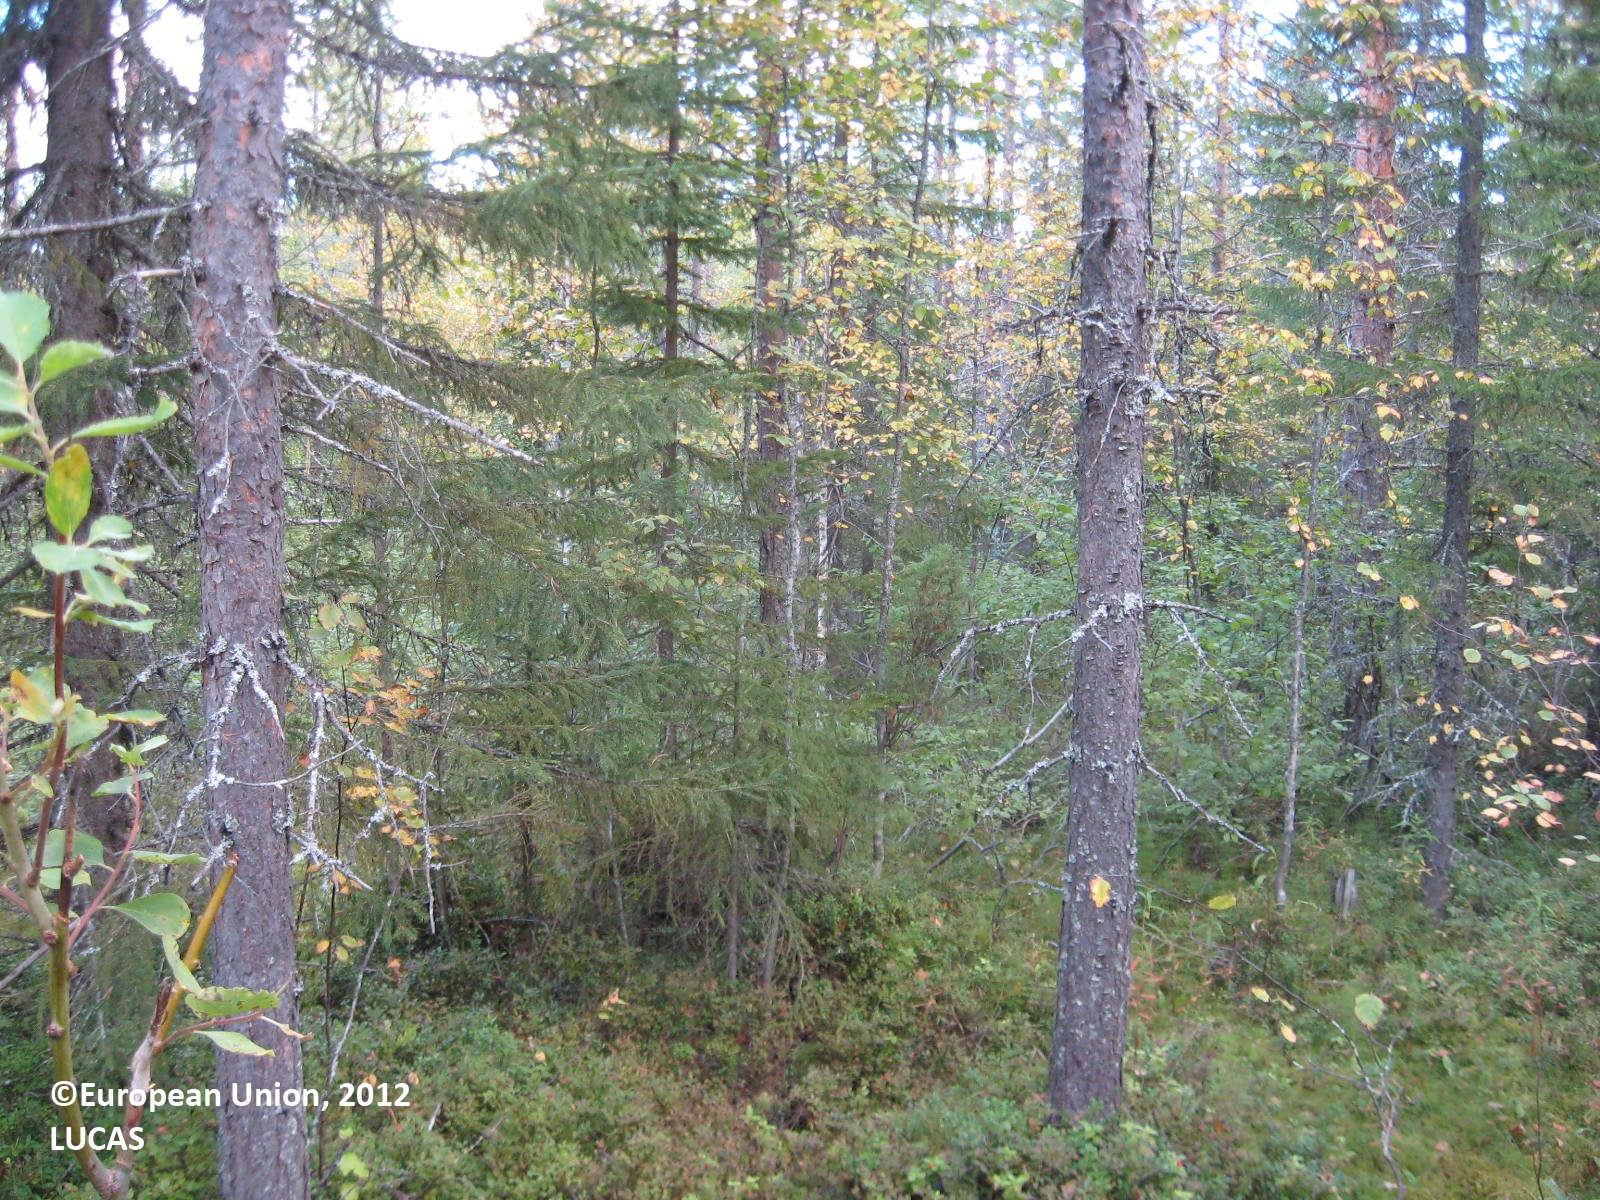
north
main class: Woodland
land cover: Other coniferous woodland
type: boreal forest
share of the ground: > 75 %
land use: Forestry
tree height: > 5 m
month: August
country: FI
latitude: 63.9477
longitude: 29.8472
